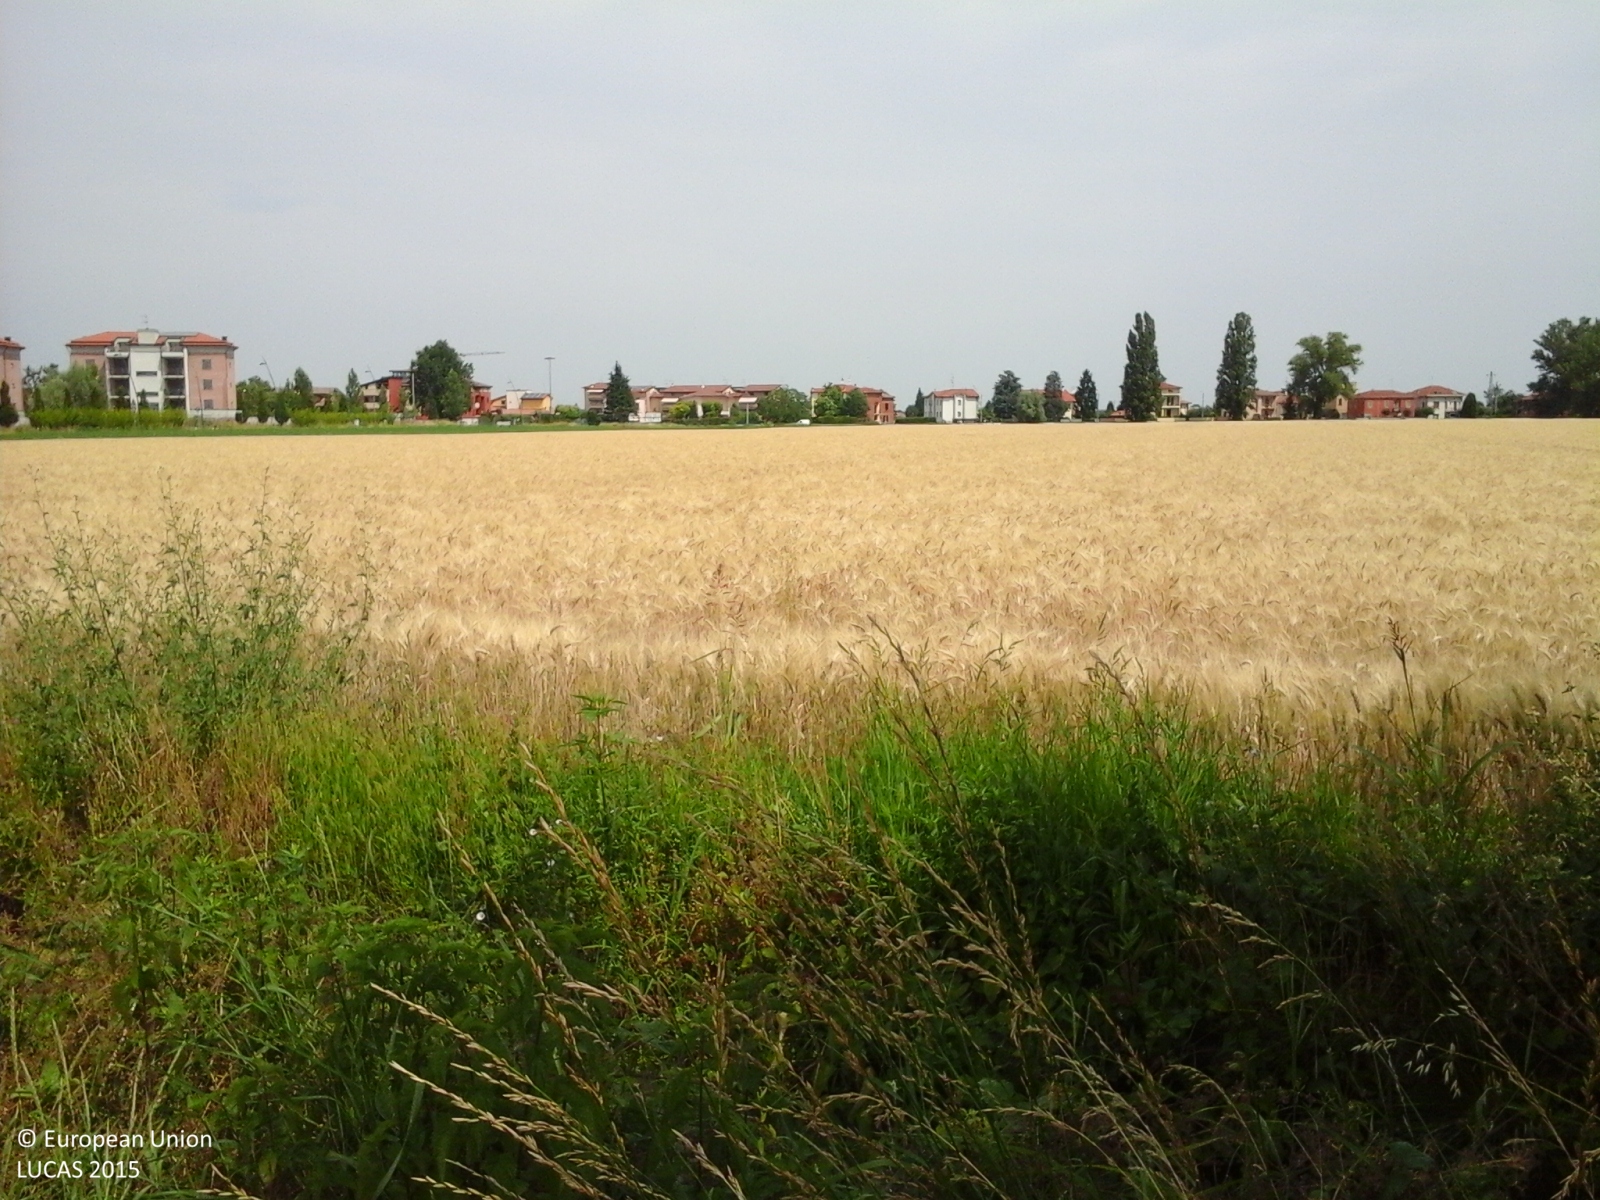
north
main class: Cropland
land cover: Common wheat
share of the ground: > 75 %
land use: Agriculture (excluding fallow land and kitchen gardens)
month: June
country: IT
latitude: 44.7830
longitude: 10.2648
